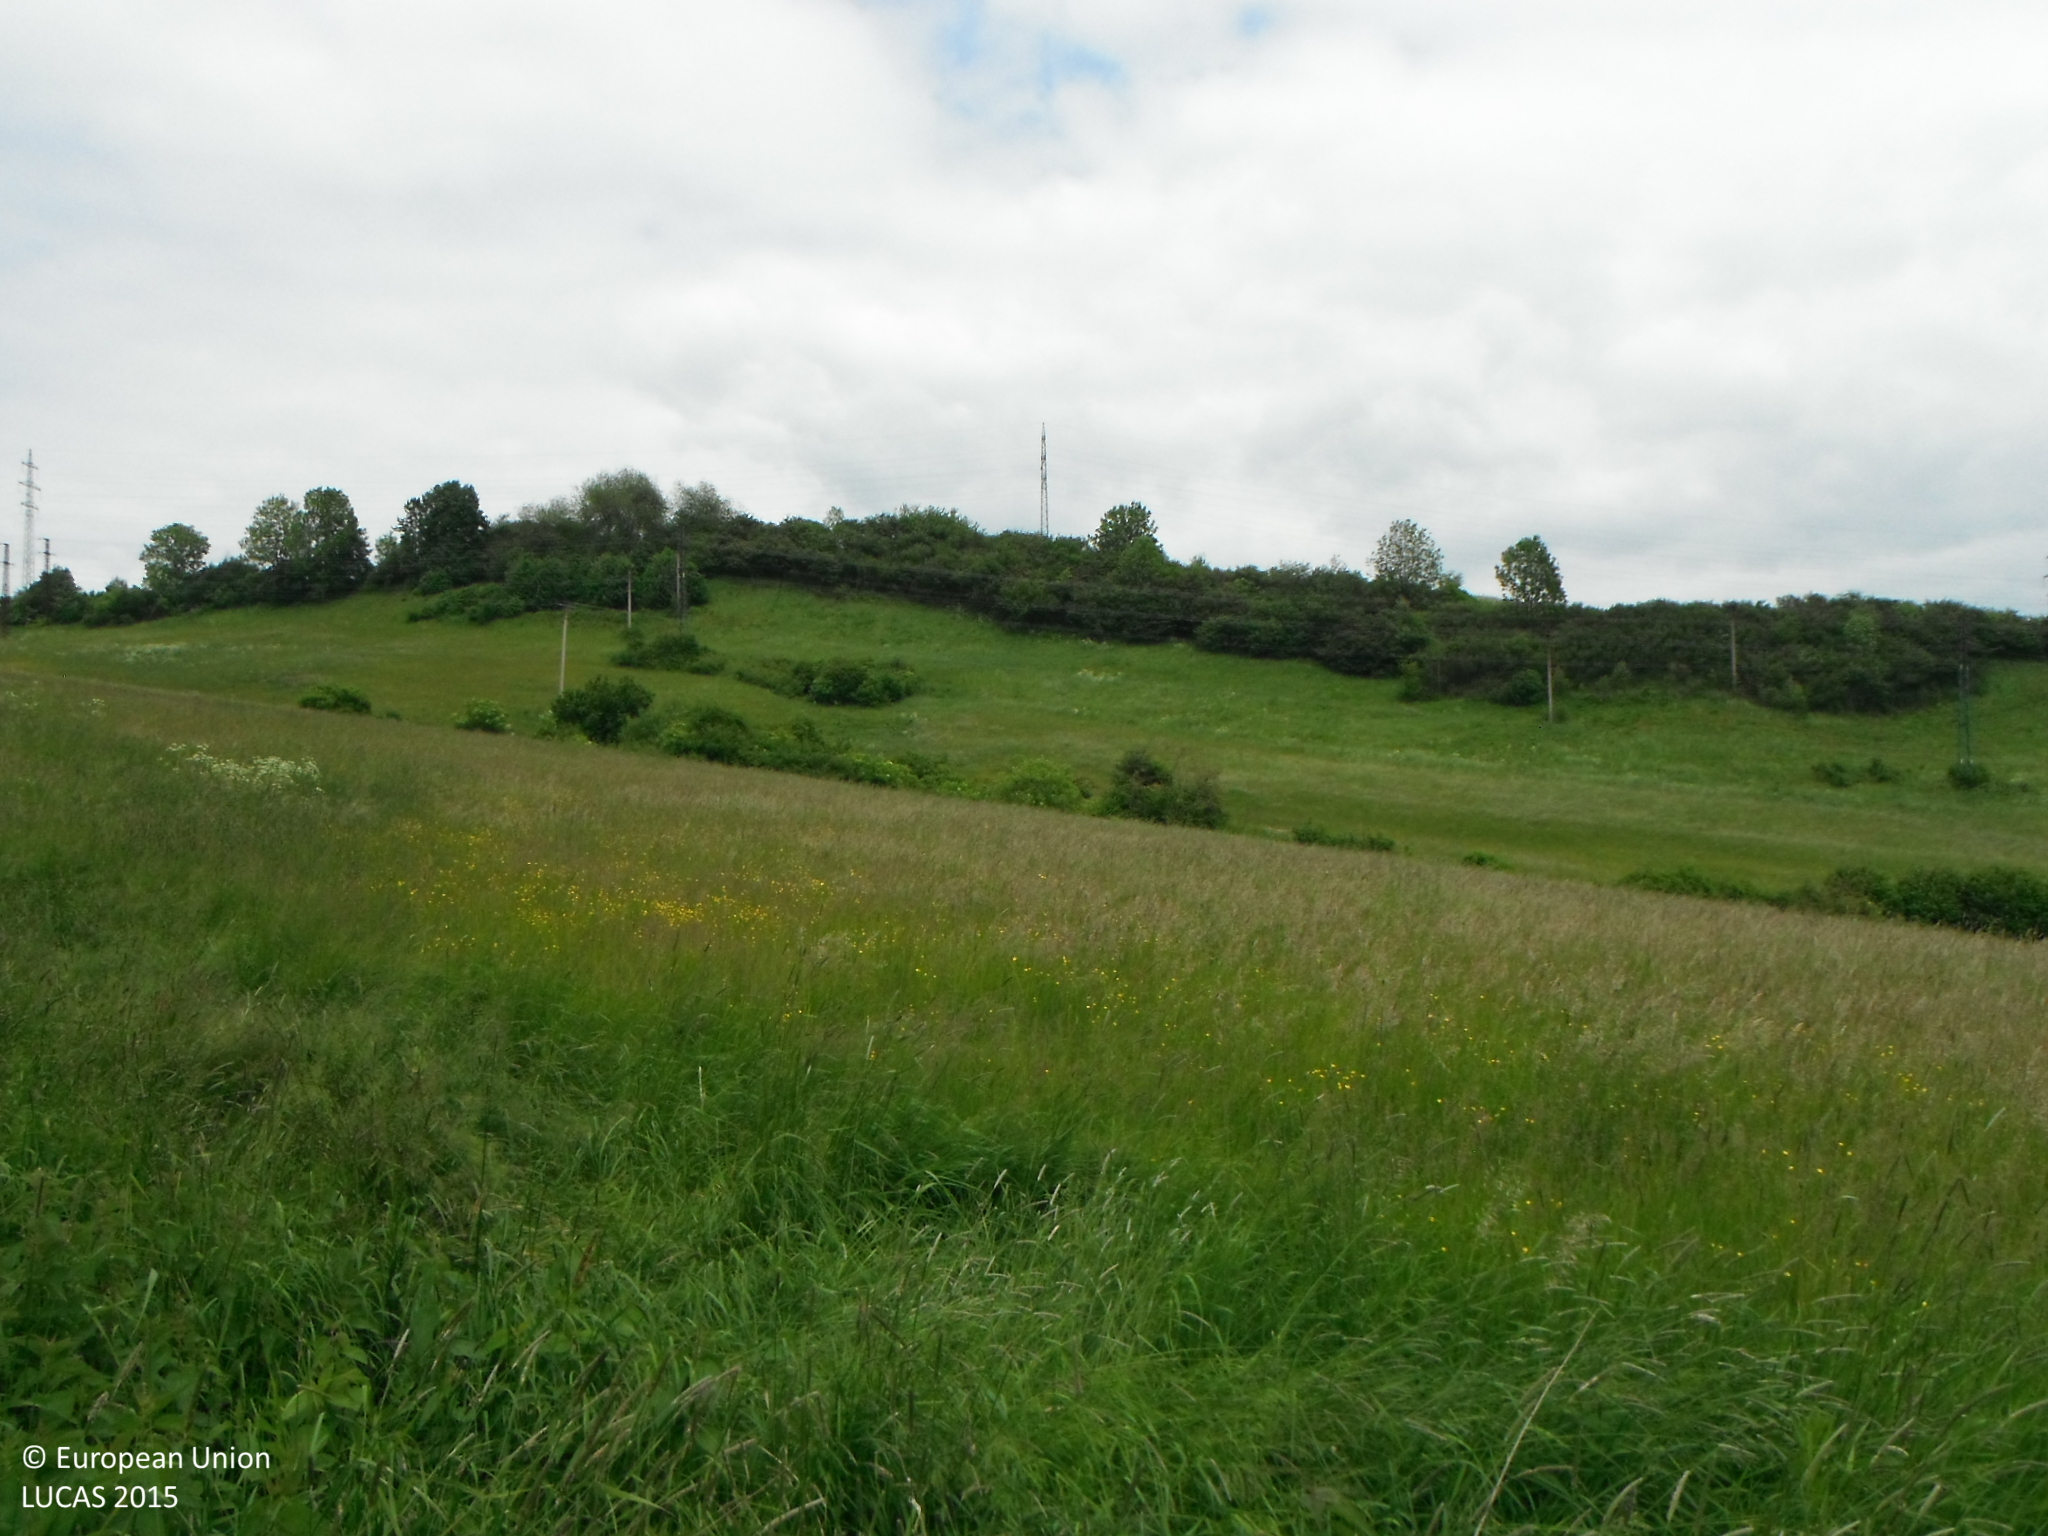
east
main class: Grassland
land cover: Grassland without tree/shrub cover
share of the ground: > 75 %
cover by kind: herbaceous plants 100 %
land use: Agriculture (excluding fallow land and kitchen gardens)
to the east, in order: Grassland without tree/shrub cover; Shrubland without tree cover; Ditches and canals; Shrubland without tree cover; Grassland without tree/shrub cover; Electric lines; Grassland without tree/shrub cover; Electric lines; Grassland without tree/shrub cover; Electric lines; Grassland without tree/shrub cover; Electric lines; Grassland without tree/shrub cover; Shrubland without tree cover; Shrubland with sparse tree cover; Grassland without tree/shrub cover
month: May
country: SK
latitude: 48.4400
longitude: 18.9281
